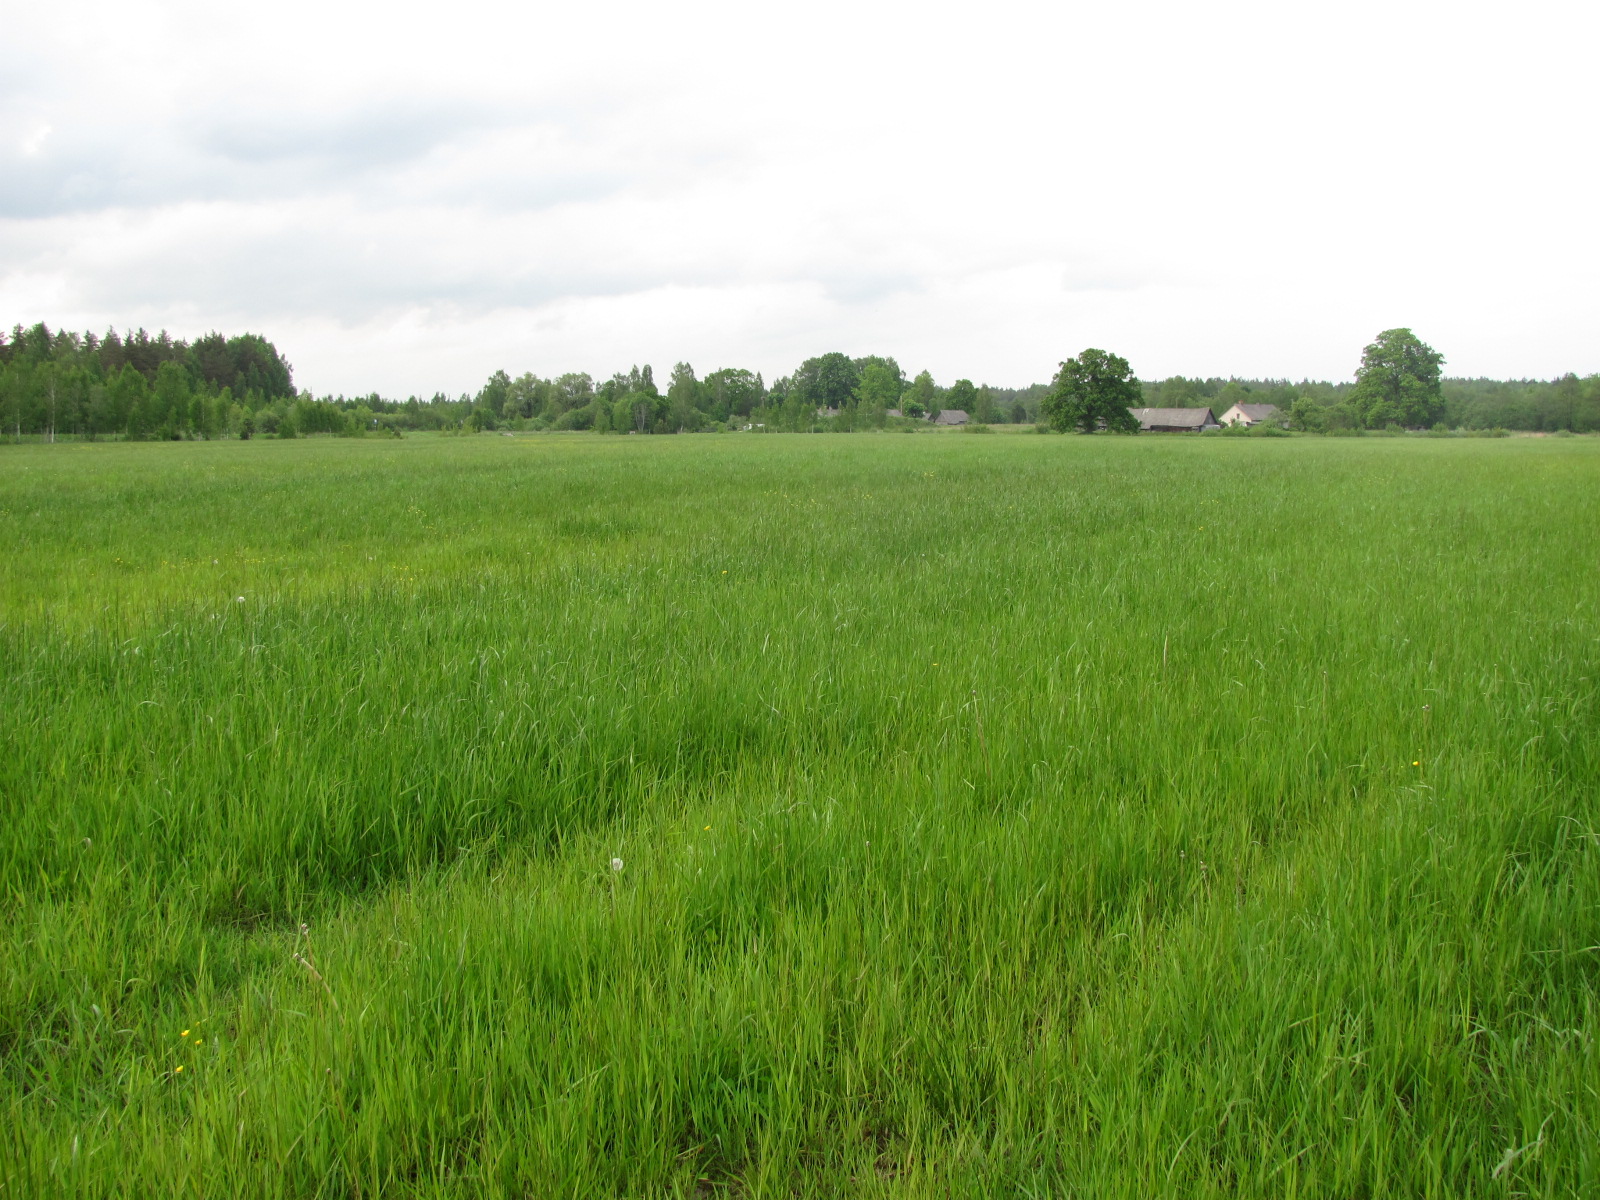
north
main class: Grassland
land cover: Grassland without tree/shrub cover
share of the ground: > 75 %
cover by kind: herbaceous plants 100 %
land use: Agriculture (excluding fallow land and kitchen gardens)
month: June
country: LV
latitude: 56.6793
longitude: 24.3078
